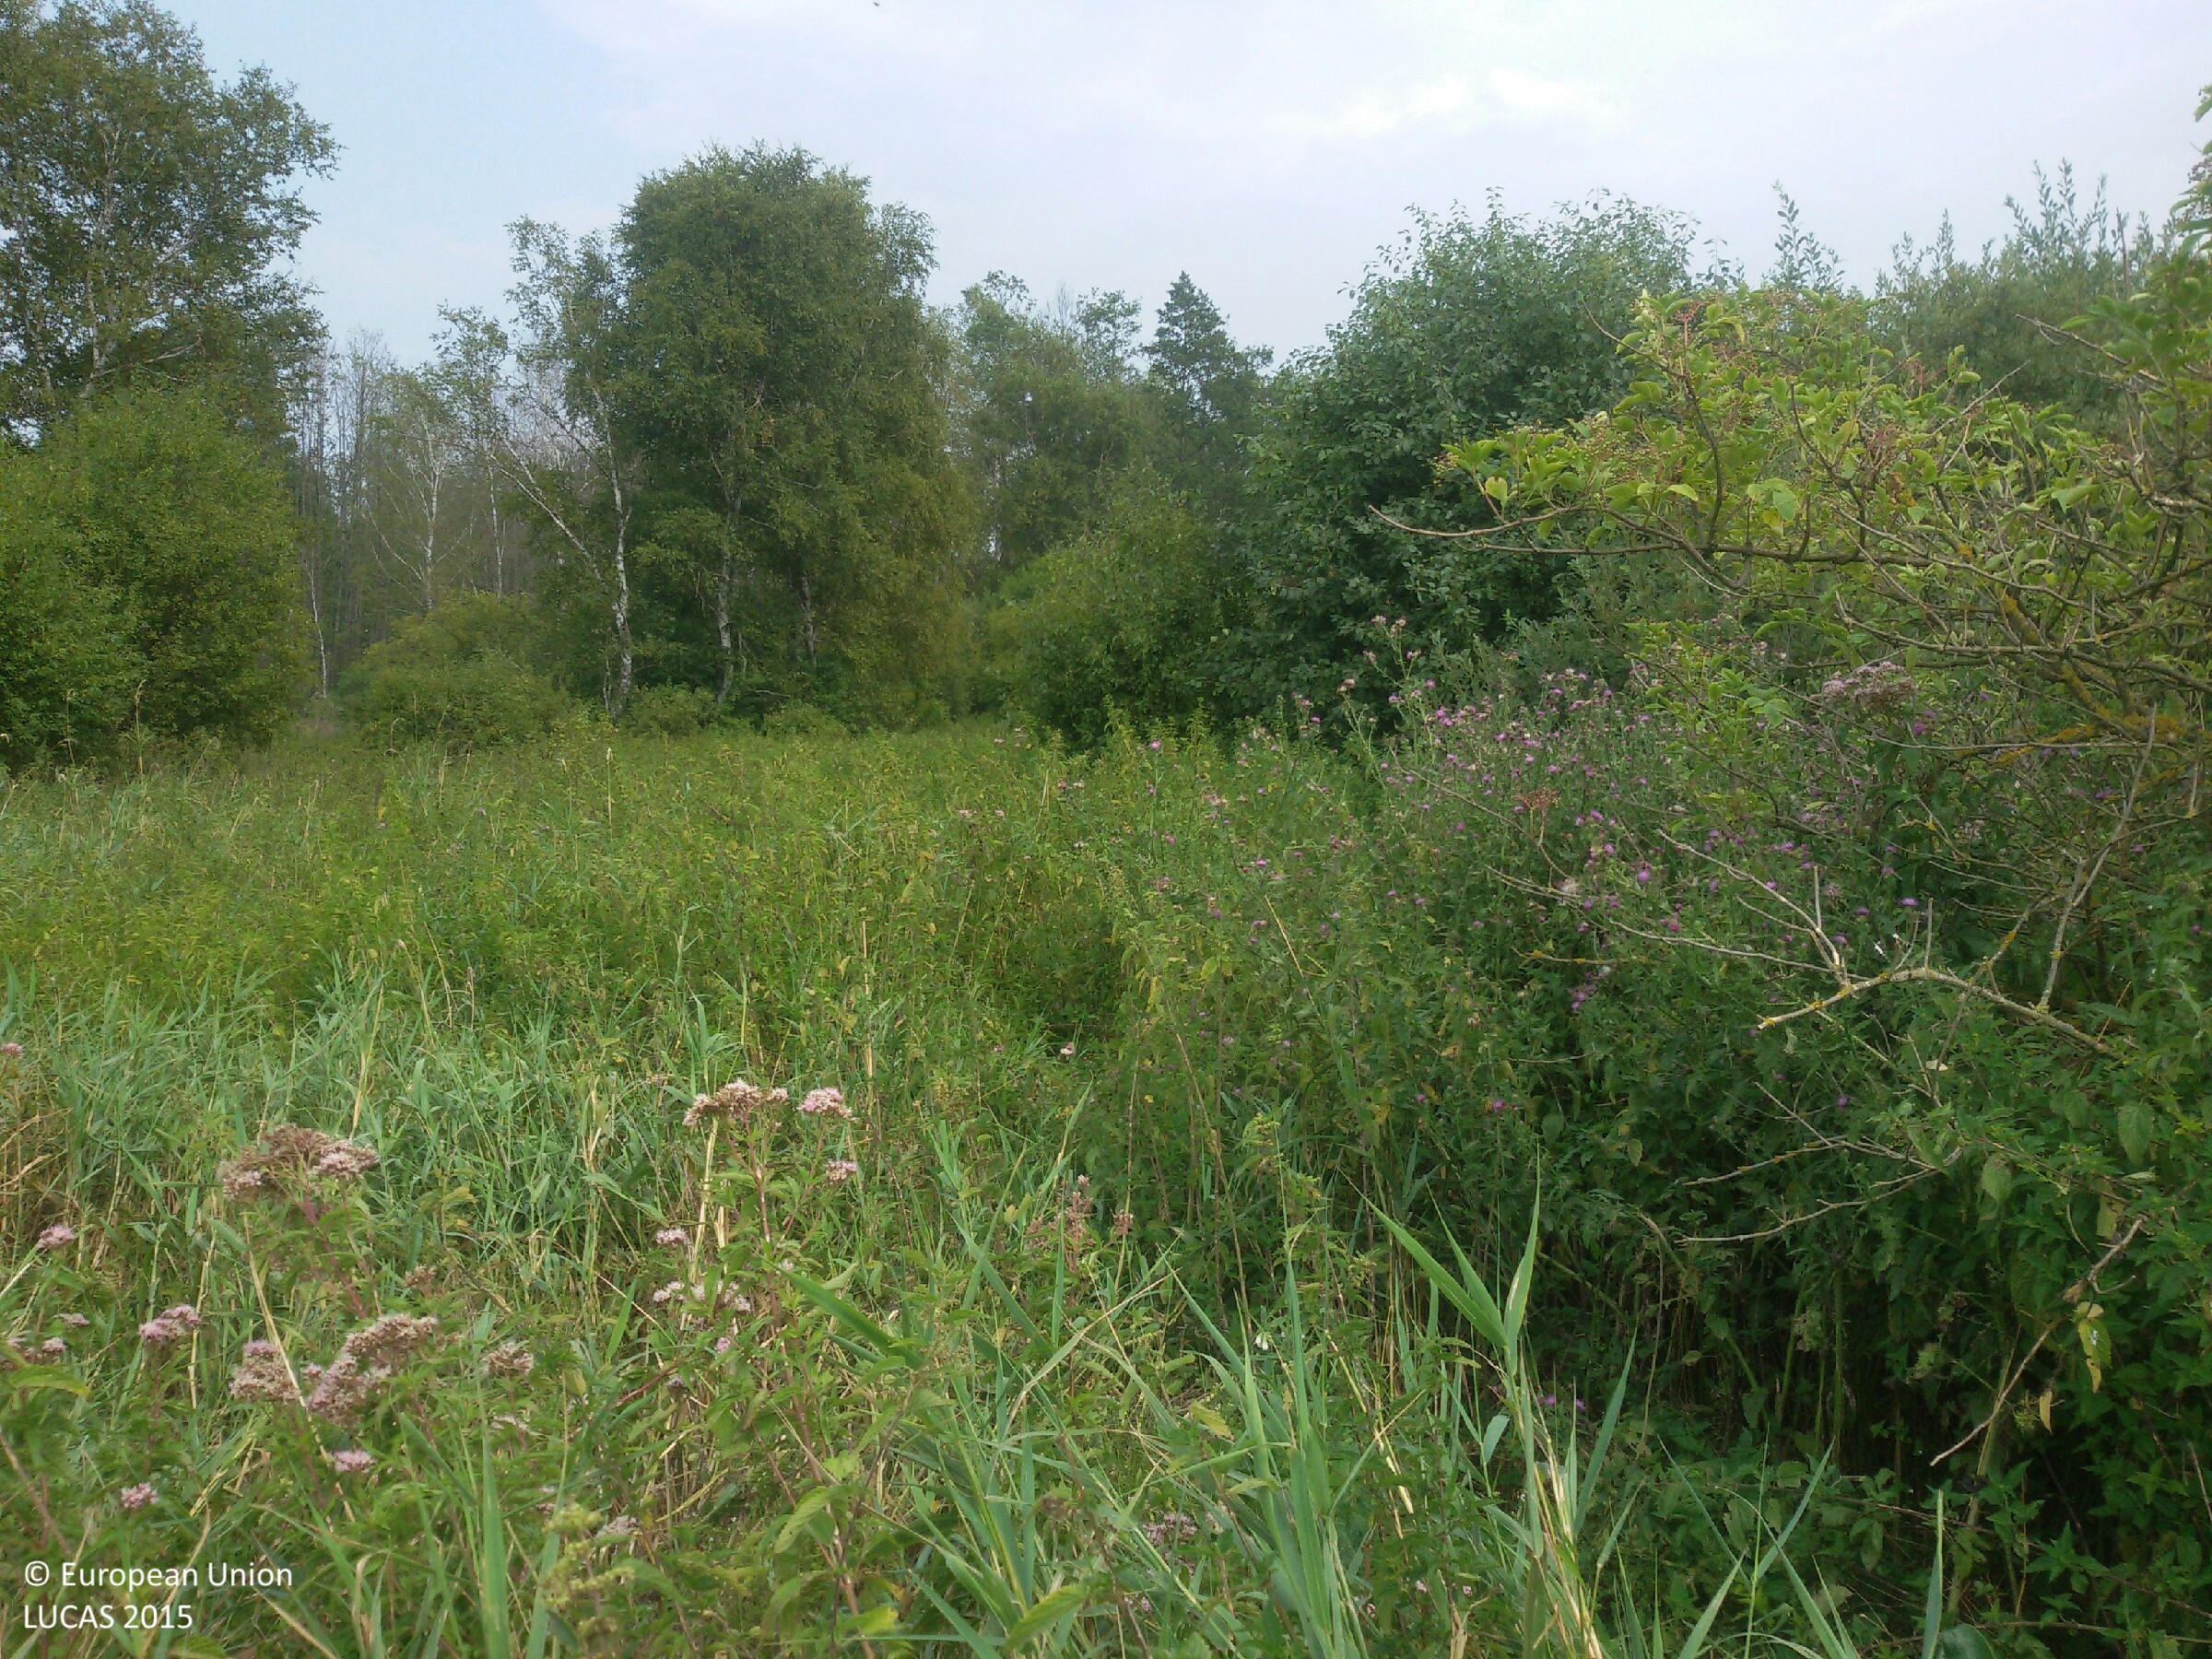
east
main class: Woodland
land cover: Broadleaved woodland
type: mesophytic deciduous forest
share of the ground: > 75 %
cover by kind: broadleaved forest trees 100 %
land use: Semi-natural and natural areas not in use
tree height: > 5 m
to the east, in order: Broadleaved woodland; Inland fresh running water; Broadleaved woodland; Pine dominated mixed woodland; Grassland without tree/shrub cover
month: August
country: PL
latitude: 51.3971
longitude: 20.9530
